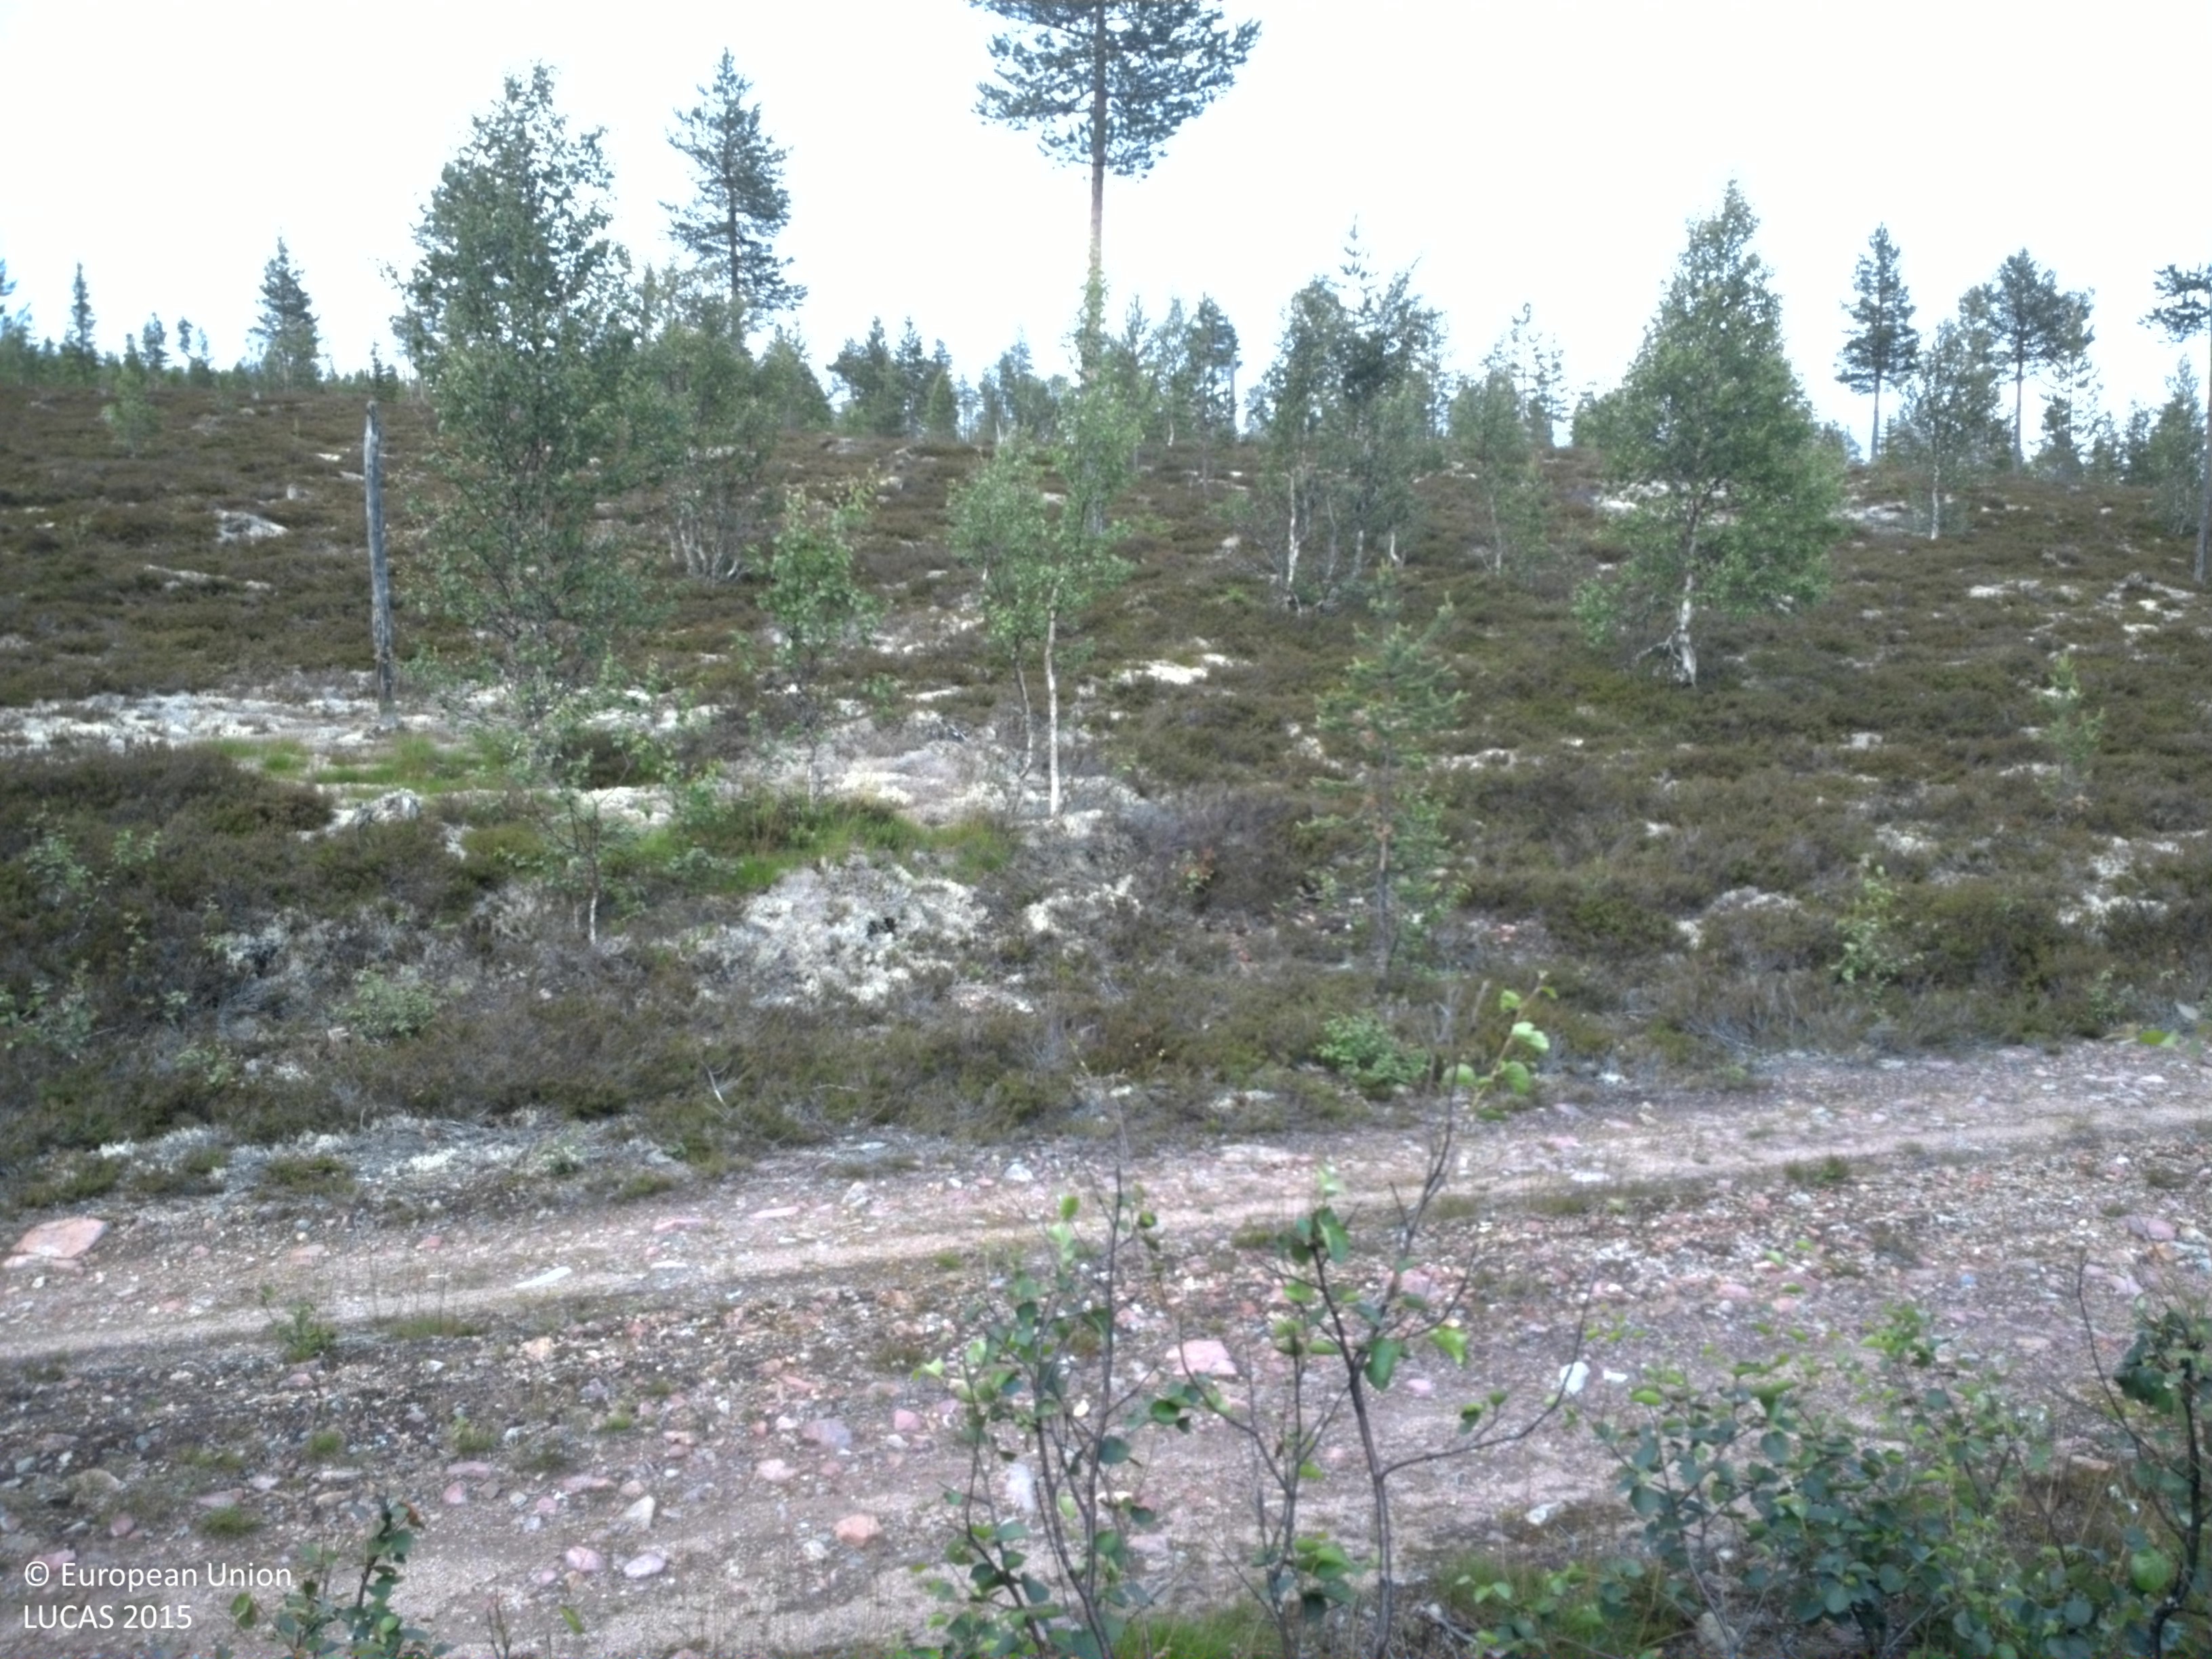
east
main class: Woodland
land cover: Broadleaved woodland
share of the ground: 50 - 75 %
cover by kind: broadleaved forest trees 70 %, shrubs 20 %, lichens and mosses 10 %
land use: Forestry
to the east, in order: Broadleaved woodland; Tracks; Pine dominated mixed woodland; Pine dominated coniferous woodland; Shrubland with sparse tree cover; Pine dominated mixed woodland; Pine dominated coniferous woodland; Peatbogs
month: July
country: SE
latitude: 61.6115
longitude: 13.6631
